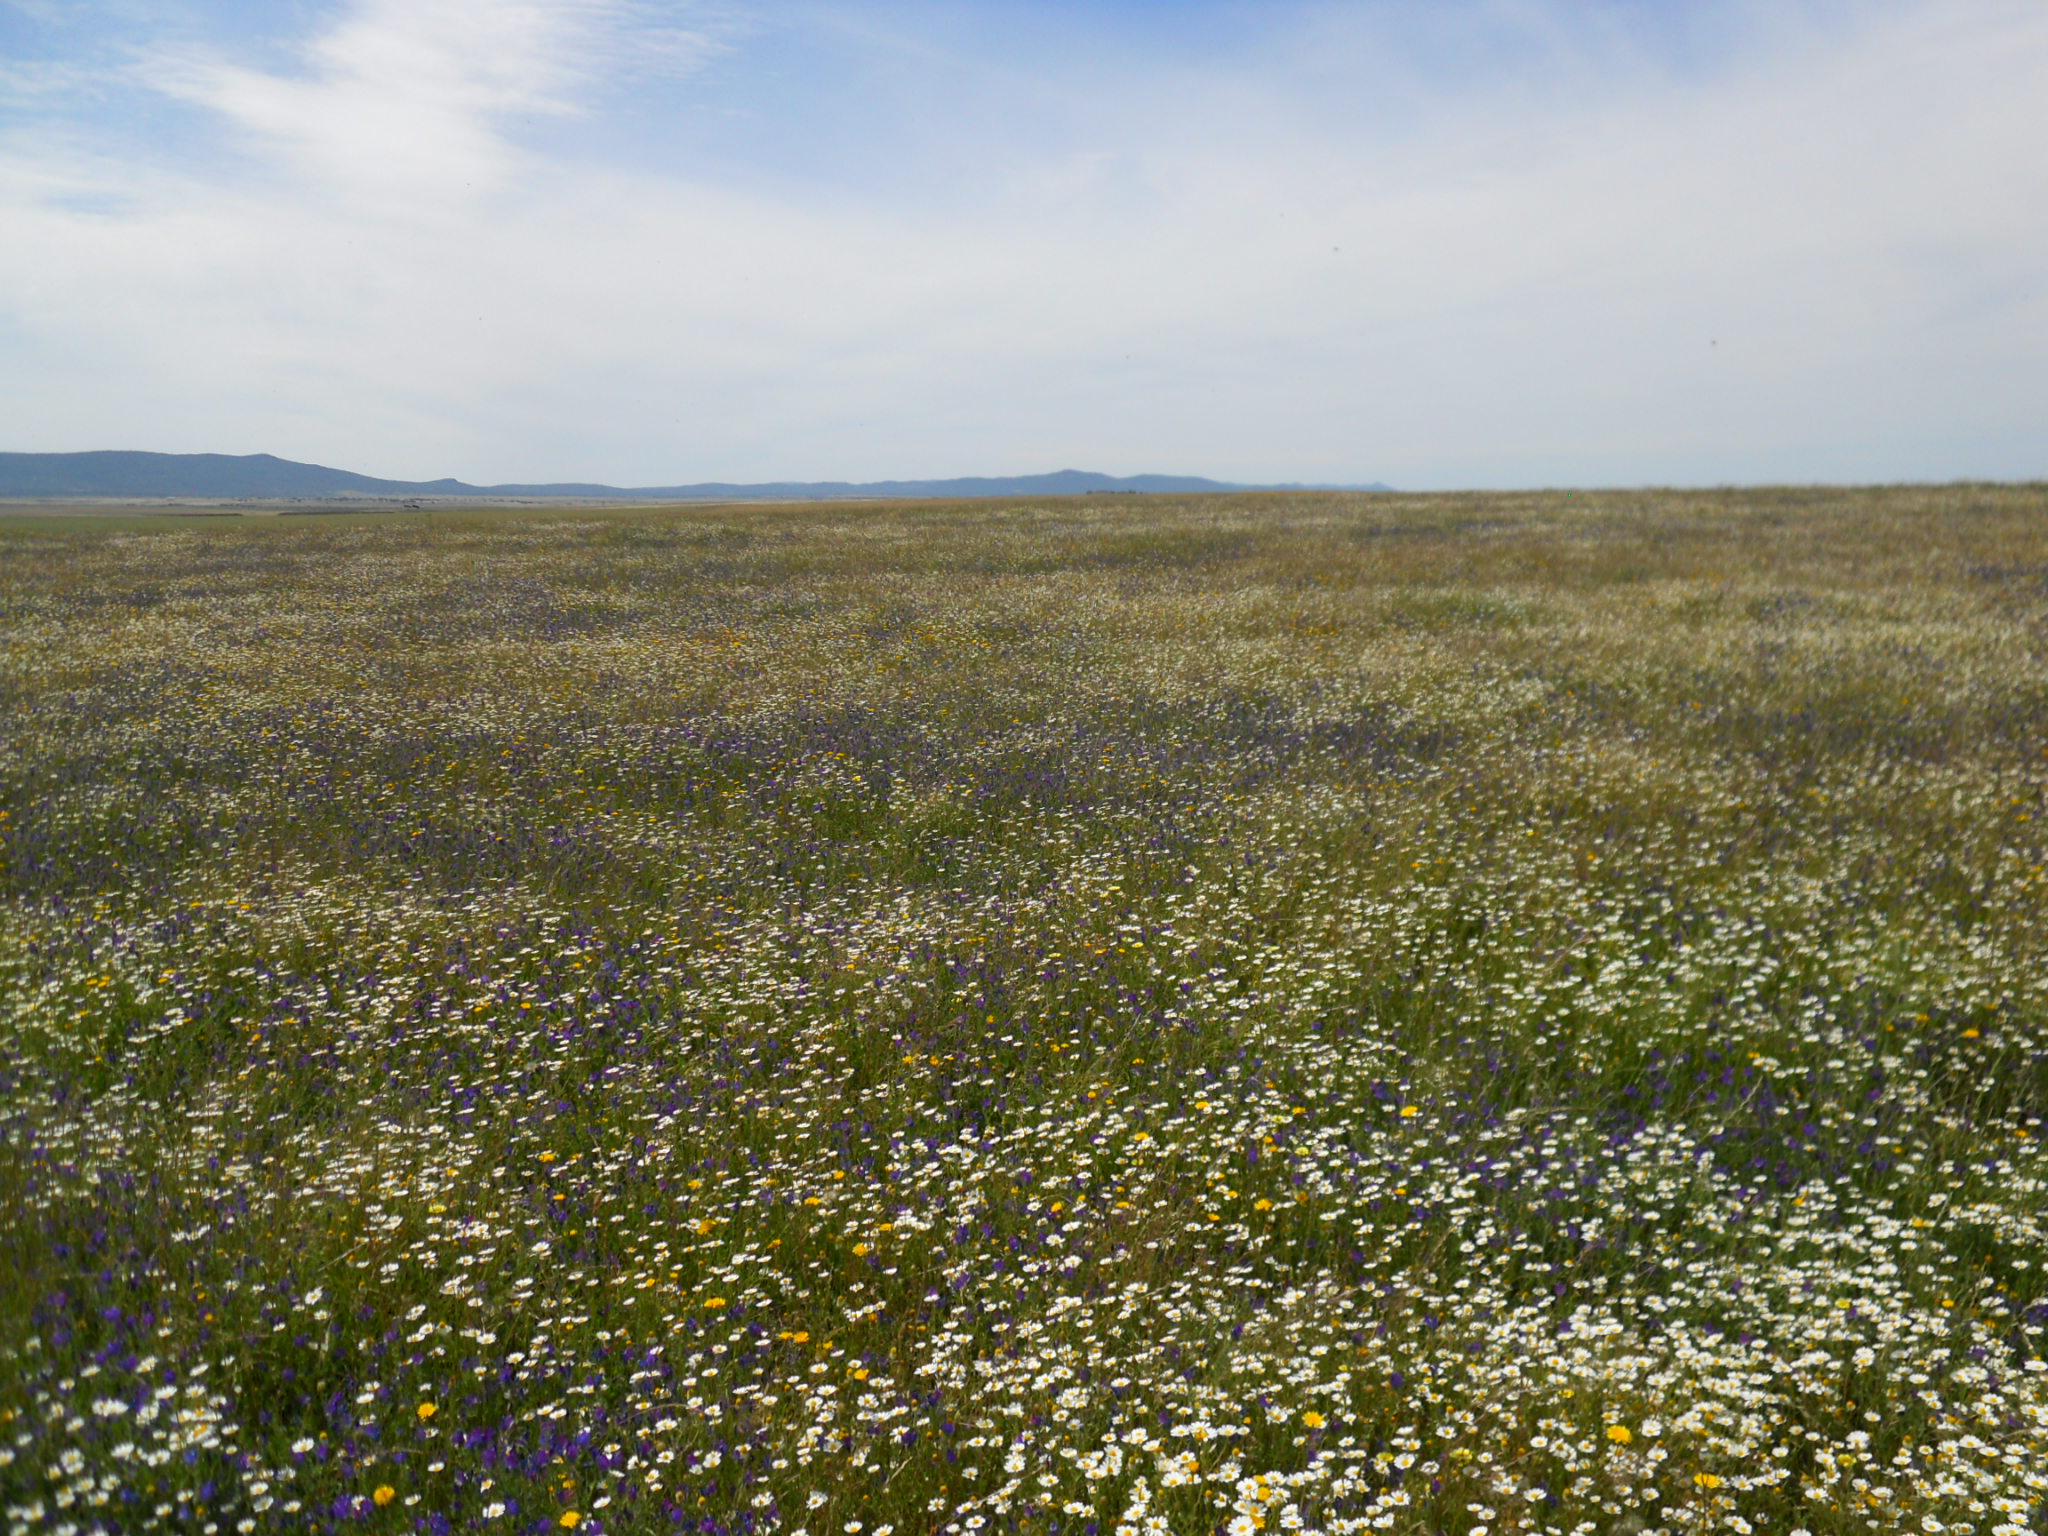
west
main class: Grassland
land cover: Spontaneously vegetated surfaces
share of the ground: > 75 %
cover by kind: herbaceous plants 100 %
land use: Agriculture (excluding fallow land and kitchen gardens)
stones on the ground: < 10 %
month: May
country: ES
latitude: 39.3251
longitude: -6.3631
